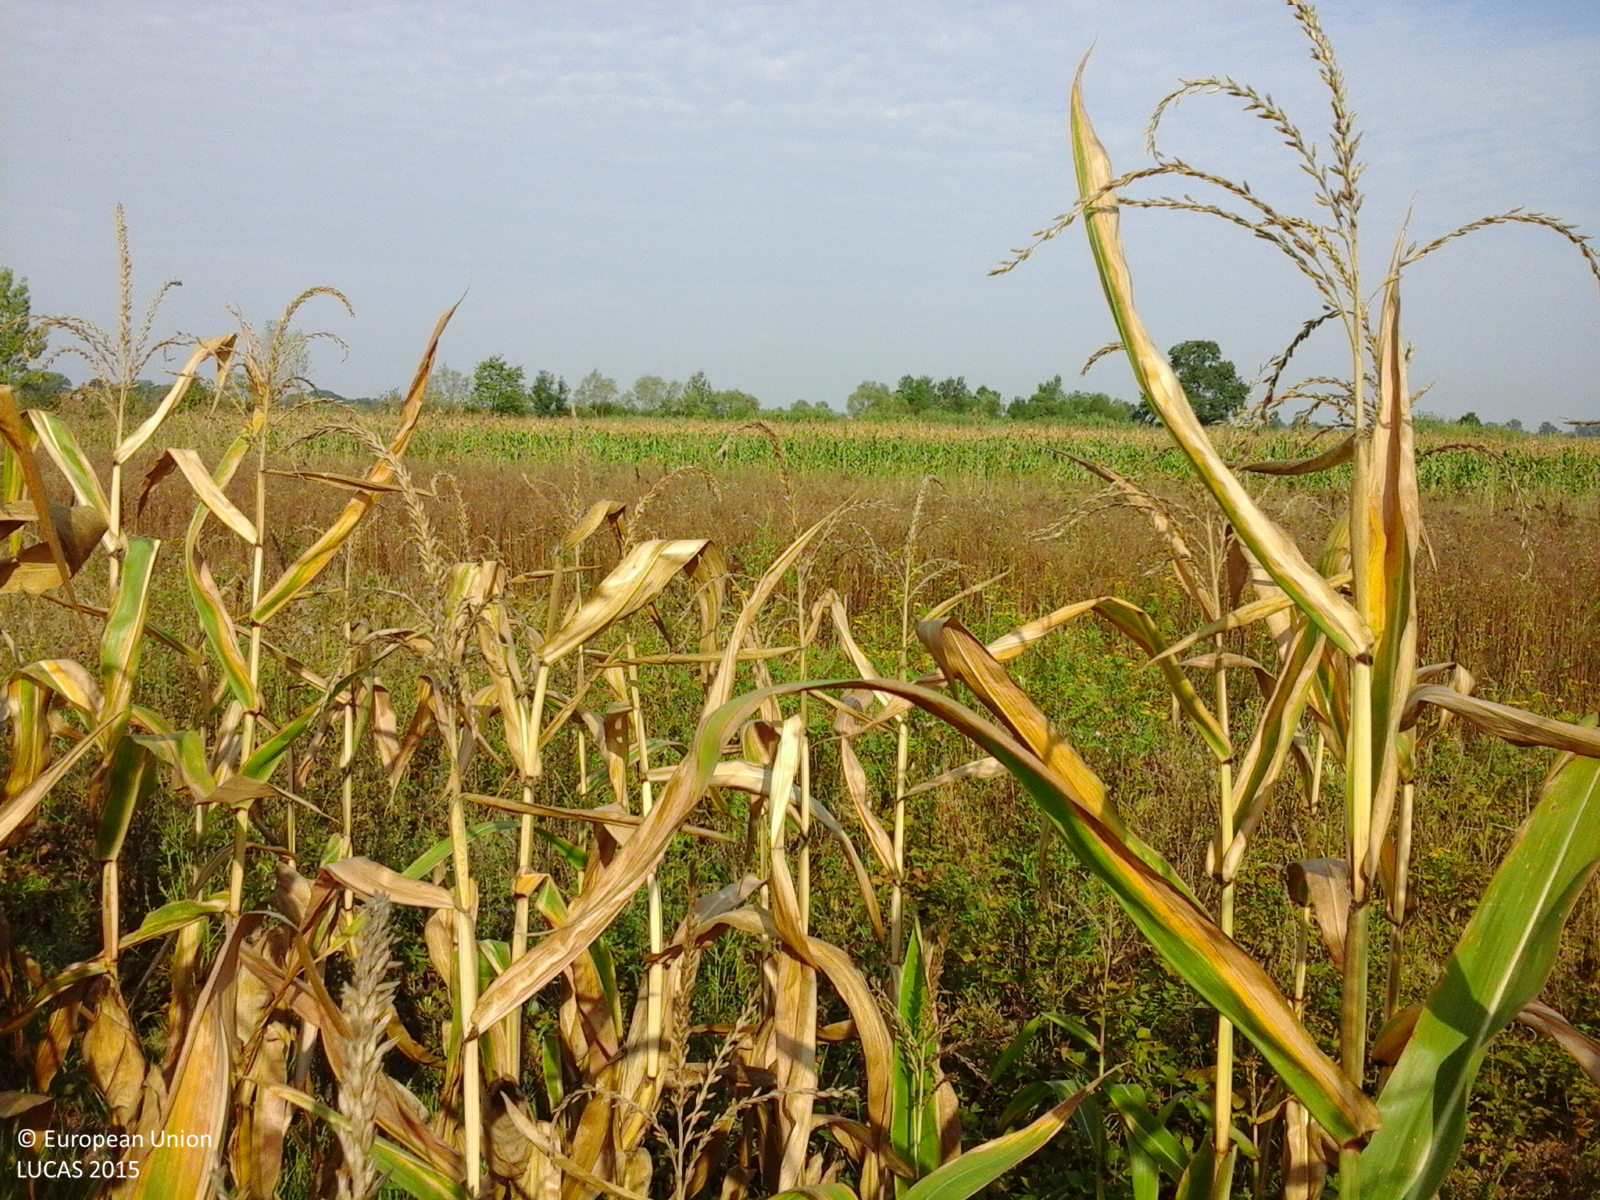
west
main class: Cropland
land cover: Maize
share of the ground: > 75 %
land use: Agriculture (excluding fallow land and kitchen gardens)
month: August
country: RO
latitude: 46.3719
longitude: 22.0957
